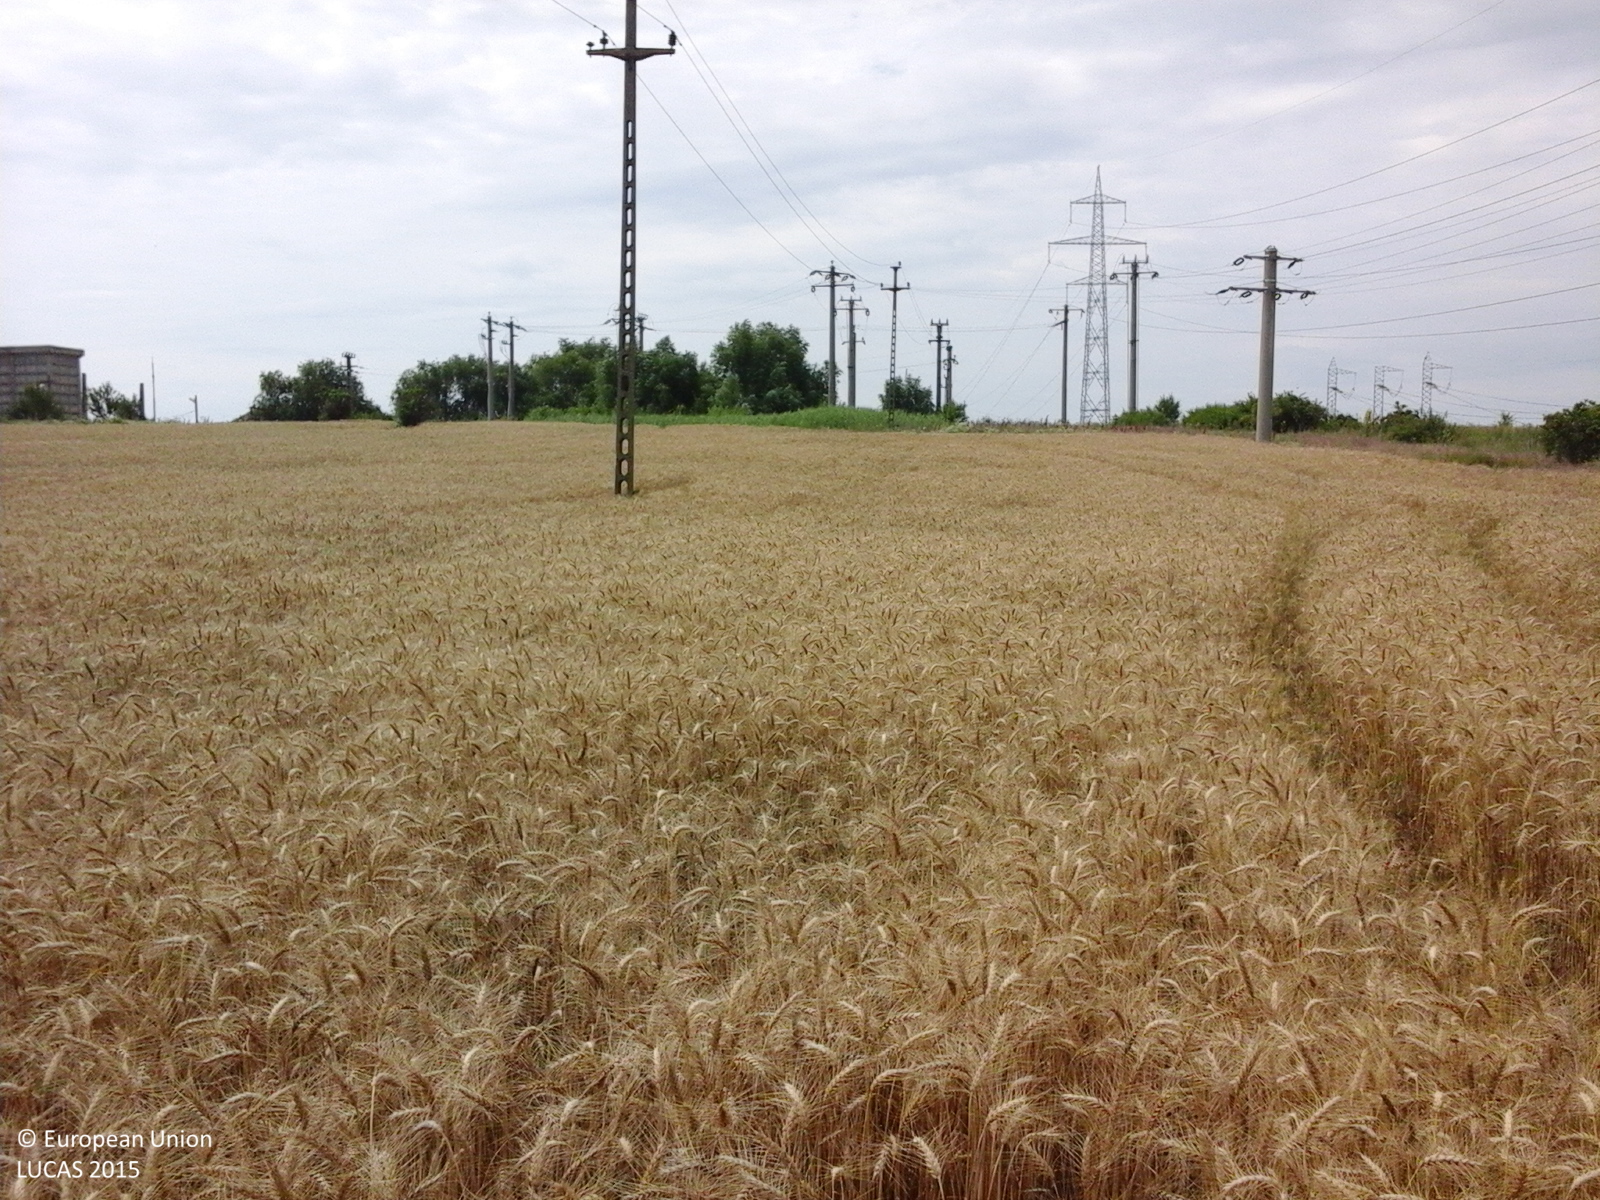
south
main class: Cropland
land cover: Common wheat
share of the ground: > 75 %
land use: Agriculture (excluding fallow land and kitchen gardens)
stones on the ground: < 10 %
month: June
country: RO
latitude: 44.3800
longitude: 26.2619
